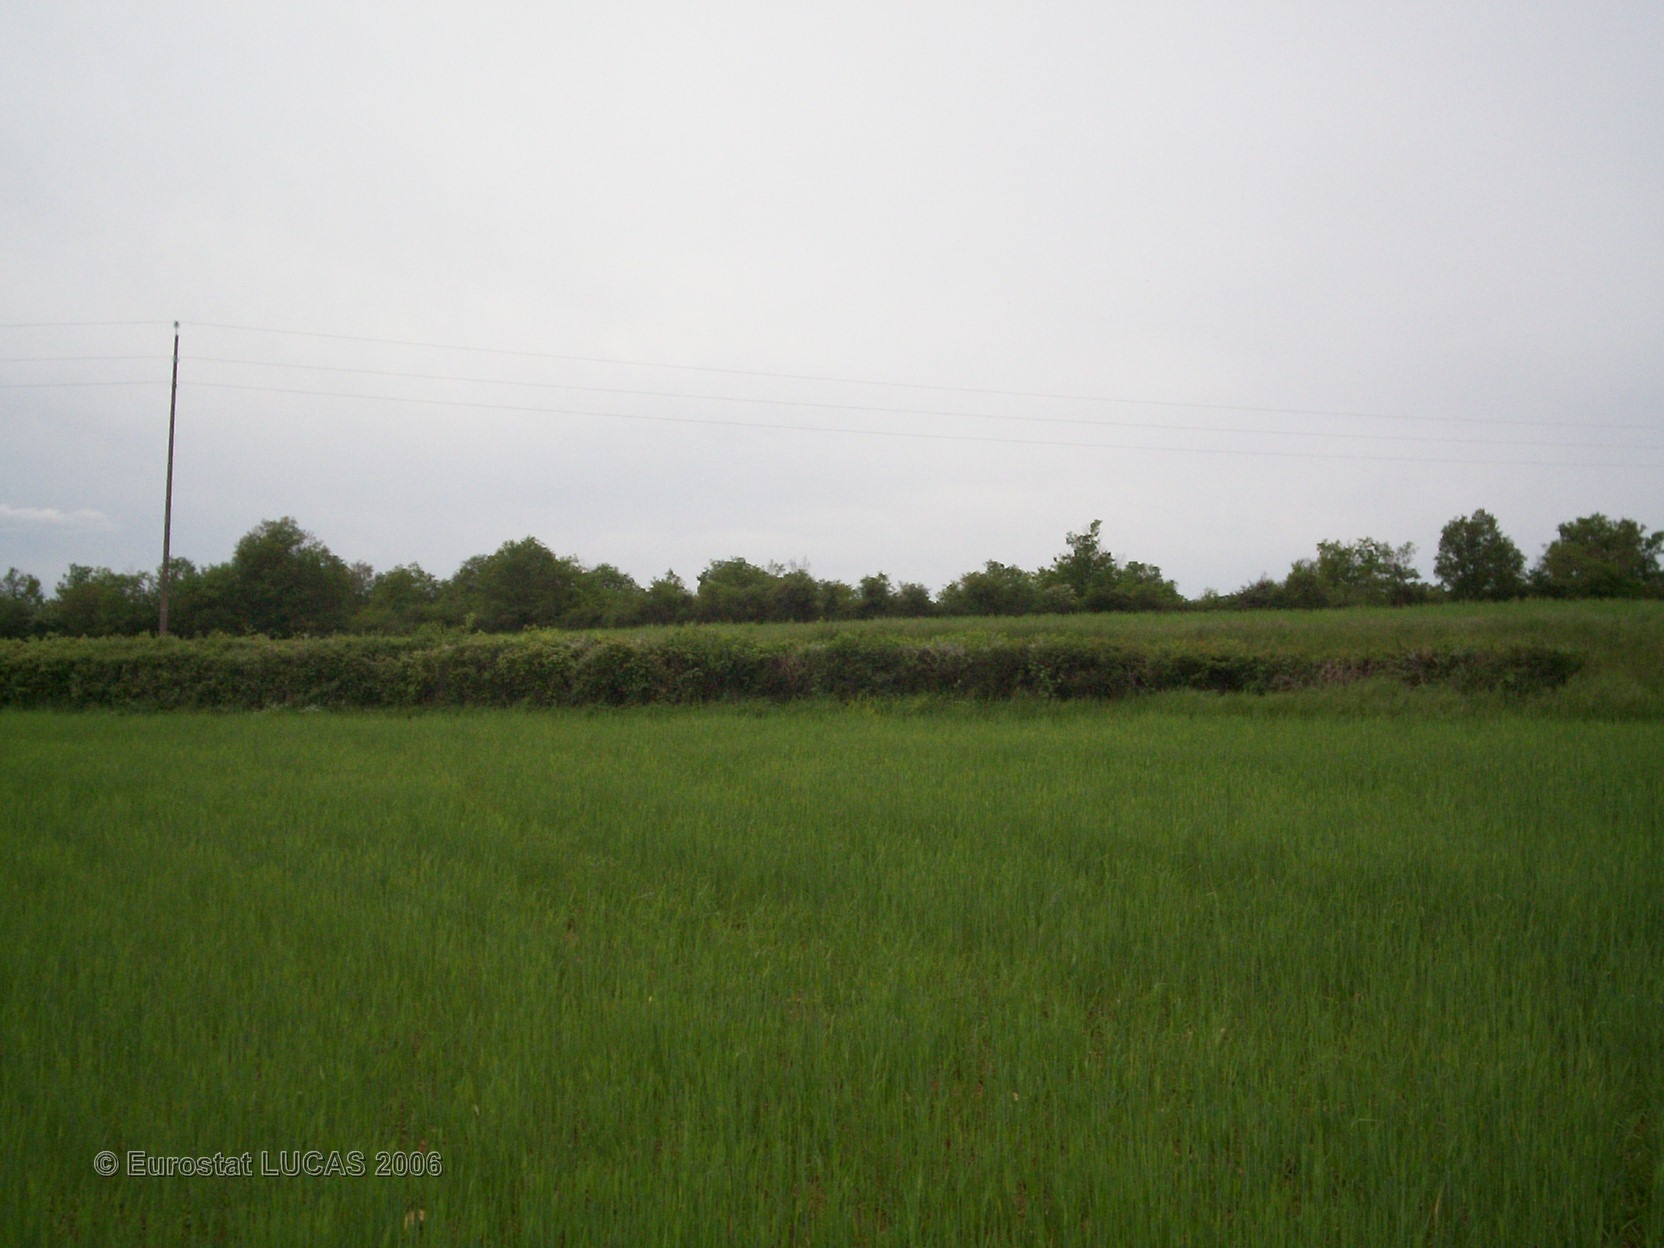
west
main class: Cropland
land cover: Barley
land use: Agriculture (excluding fallow land and kitchen gardens)
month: May
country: FR
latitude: 46.5598
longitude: 4.6401
